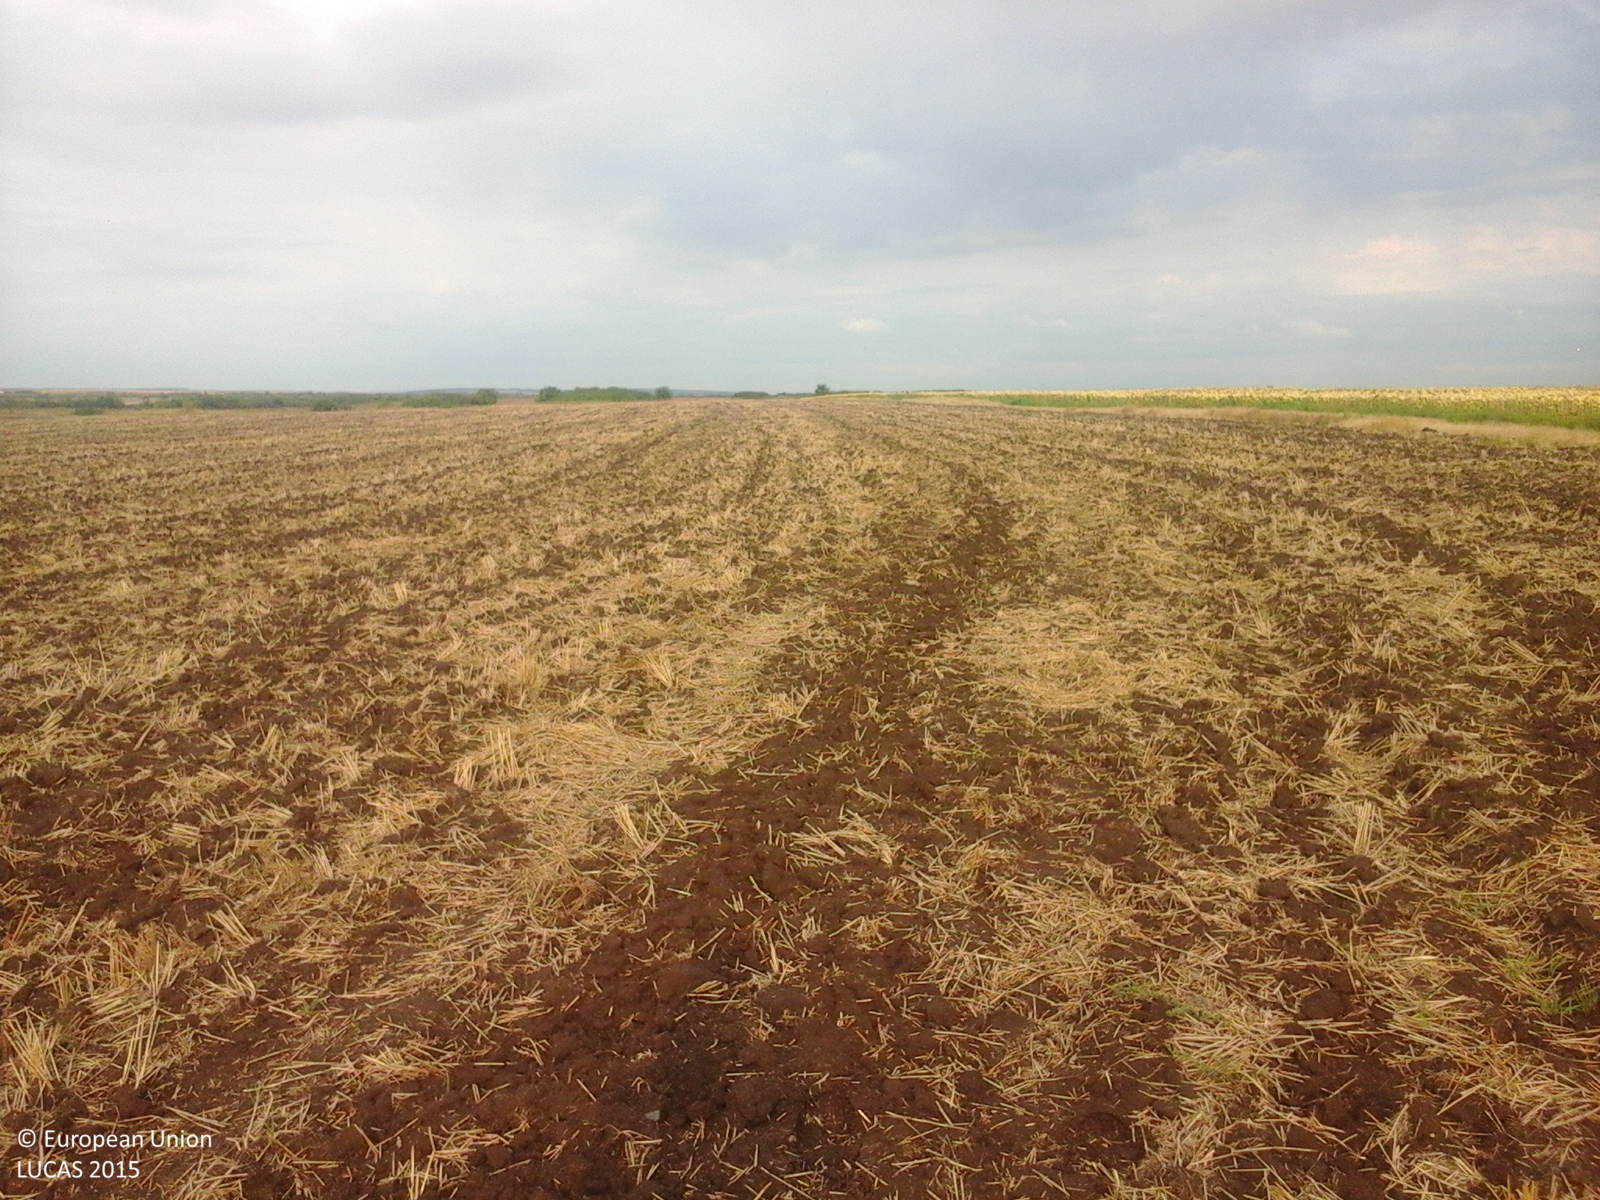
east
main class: Cropland
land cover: Common wheat
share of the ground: 25 - 50 %
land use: Agriculture (excluding fallow land and kitchen gardens)
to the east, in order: Common wheat
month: August
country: RO
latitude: 45.8209
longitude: 21.3198
